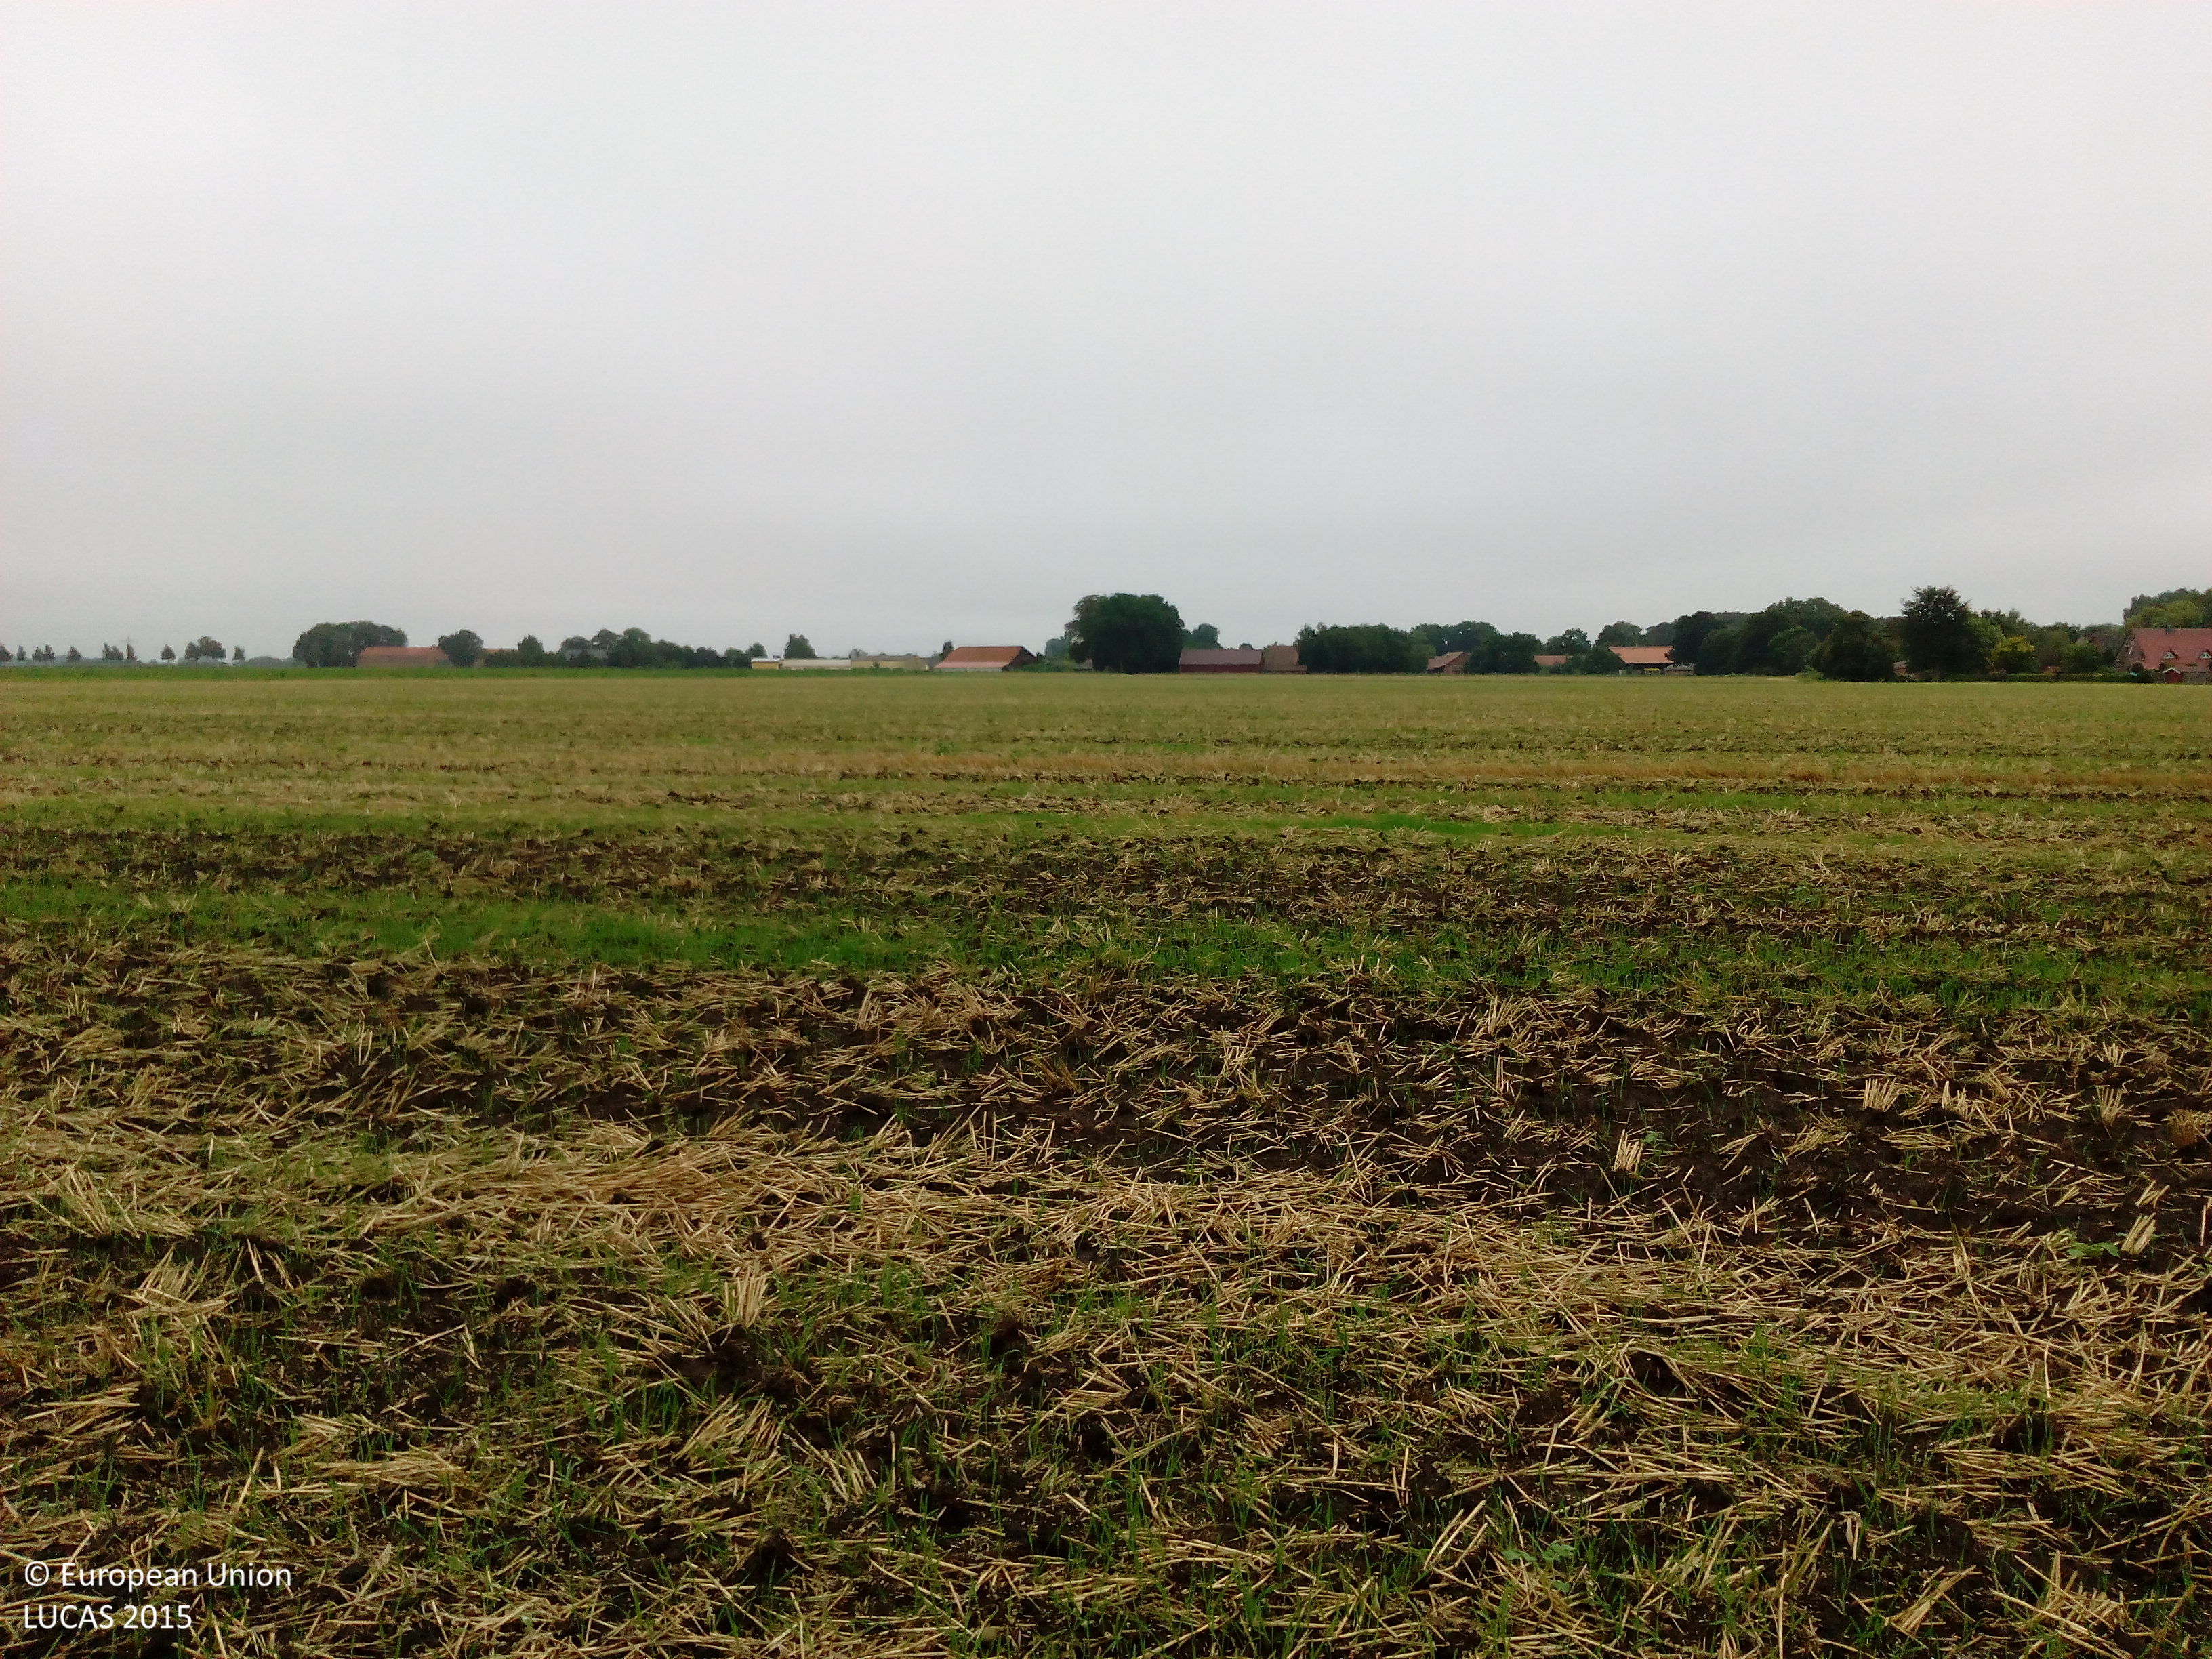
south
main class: Cropland
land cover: Common wheat
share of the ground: 25 - 50 %
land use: Agriculture (excluding fallow land and kitchen gardens)
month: August
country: DE
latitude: 52.8006
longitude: 8.5914
